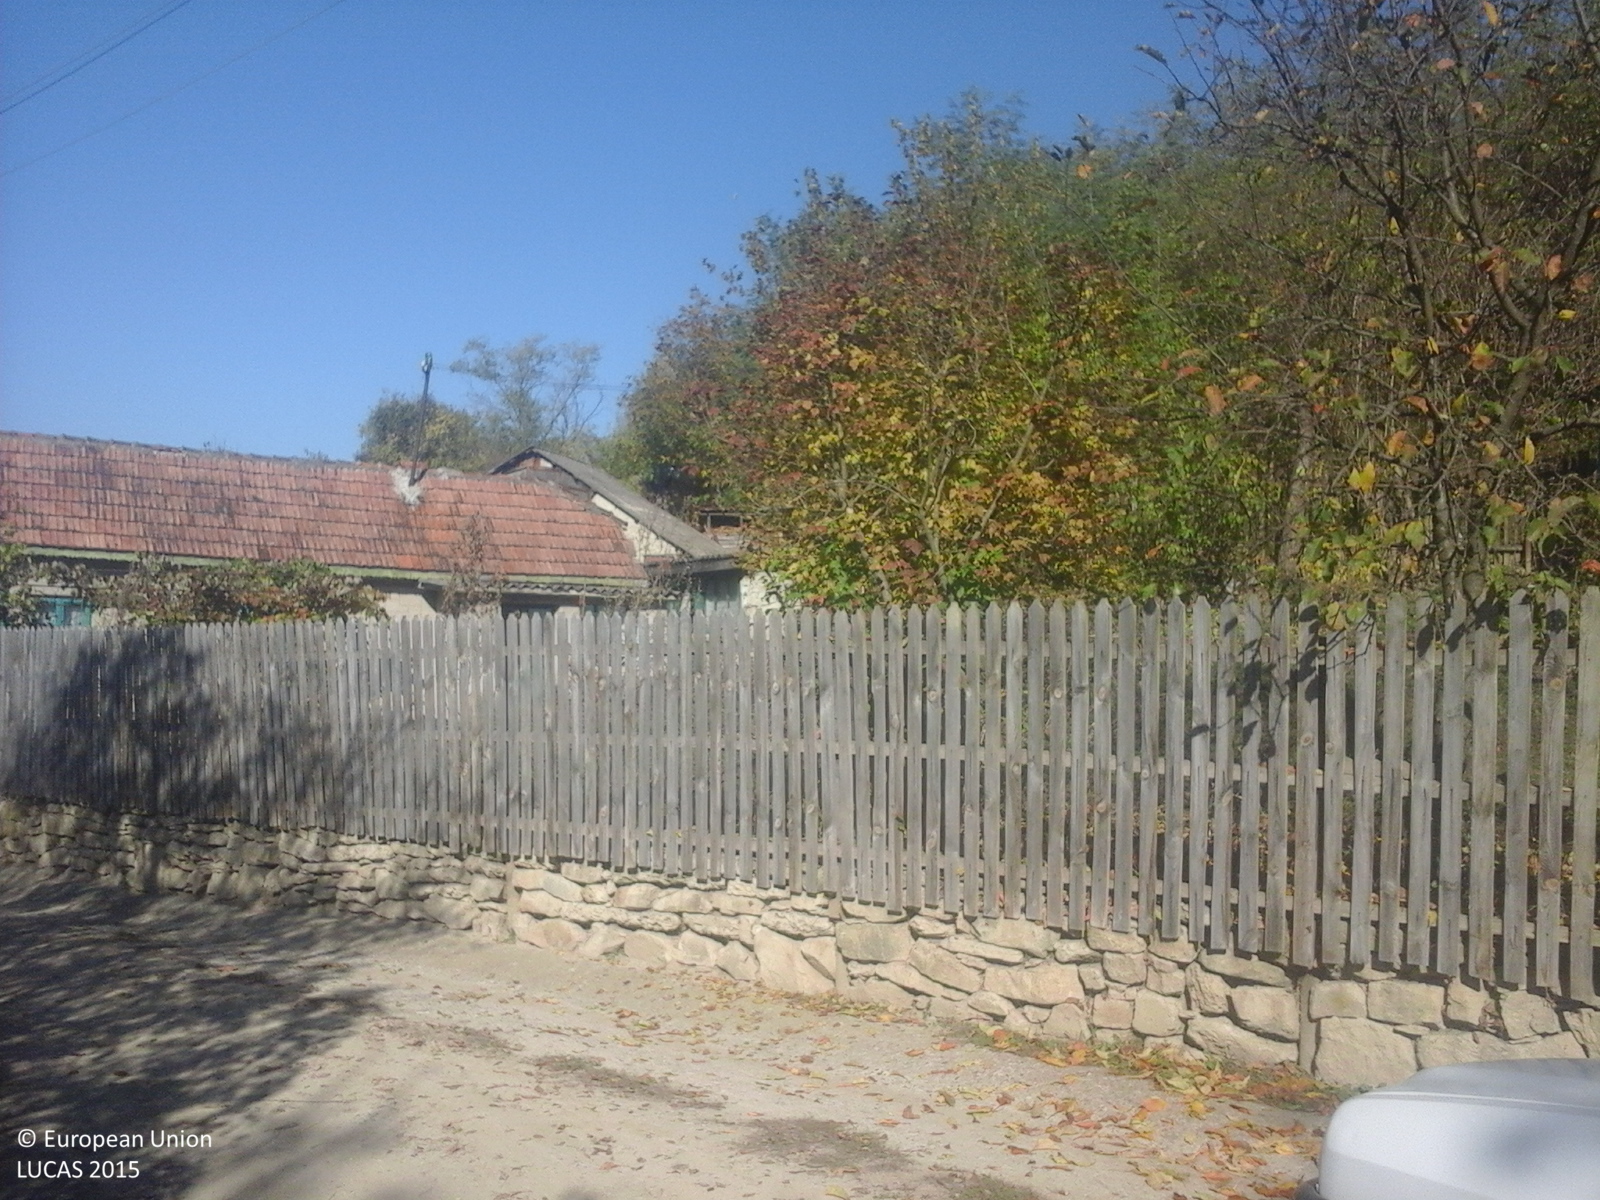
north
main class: Woodland
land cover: Broadleaved woodland
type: beech forest
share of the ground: > 75 %
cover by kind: broadleaved forest trees 100 %
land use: Forestry
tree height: > 5 m
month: October
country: RO
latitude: 45.3729
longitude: 26.7170
